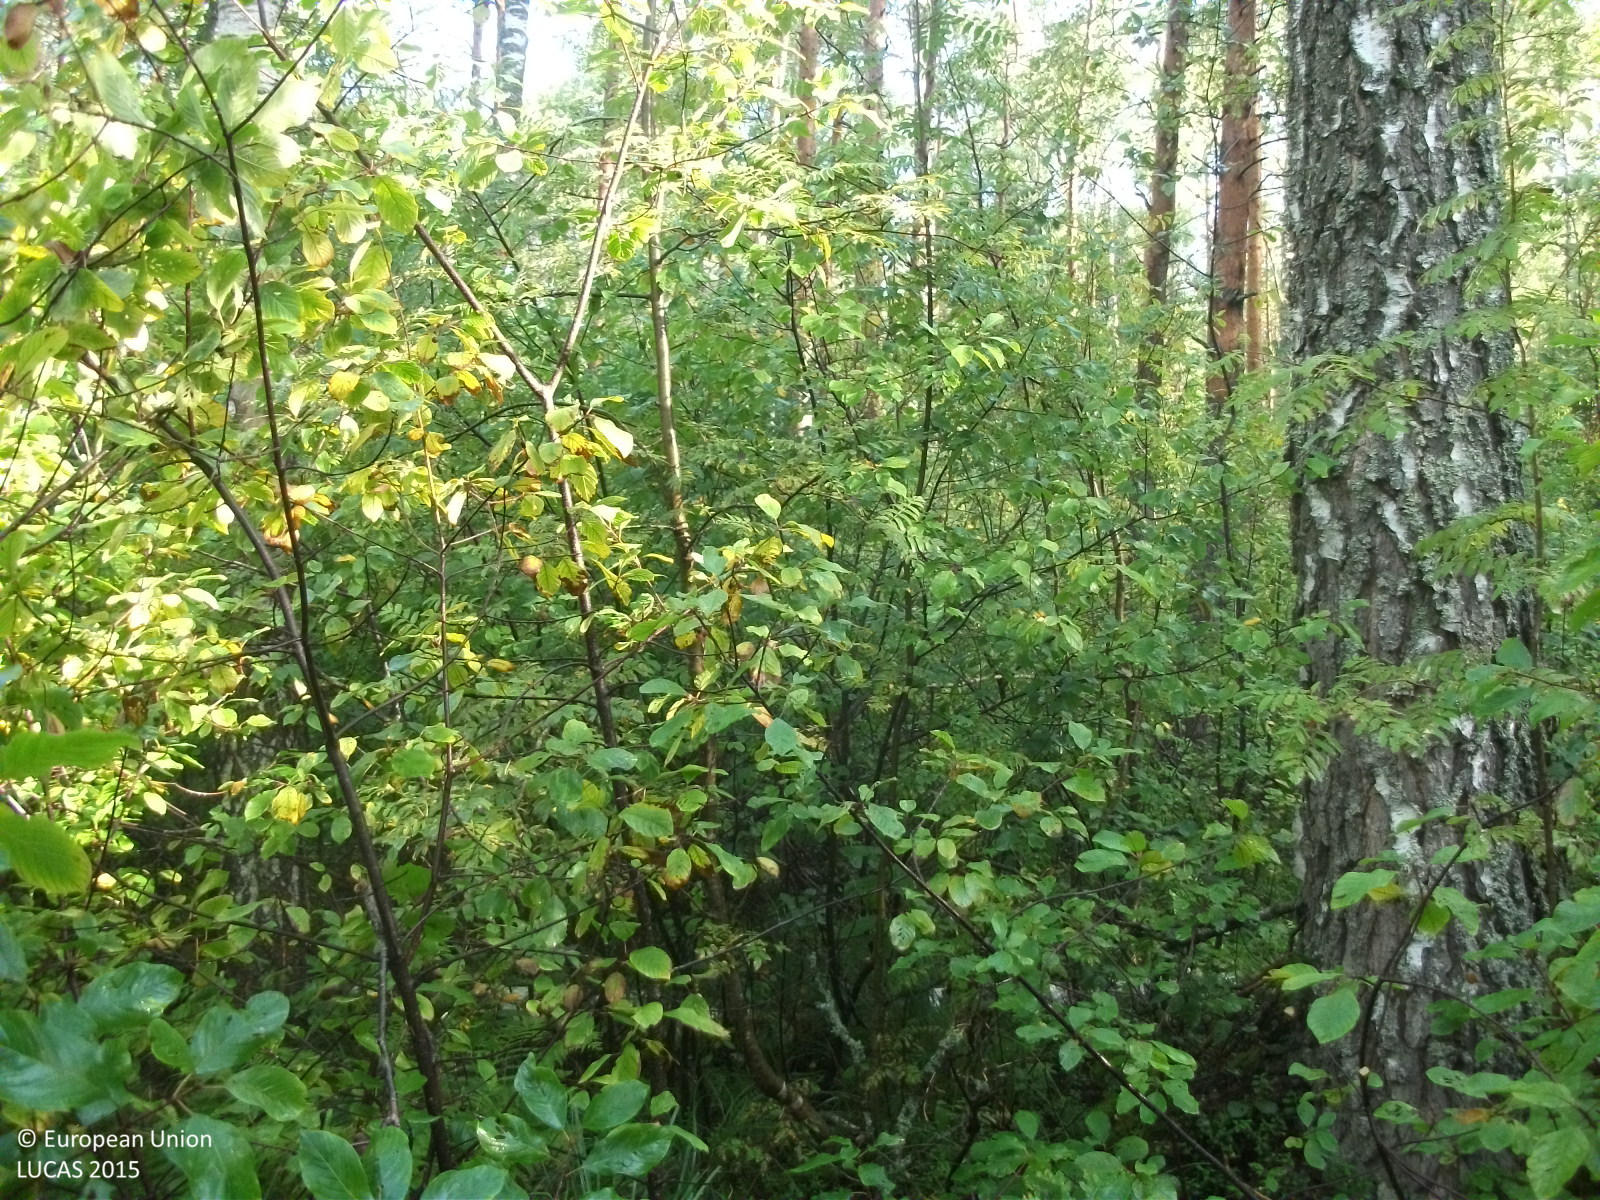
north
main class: Woodland
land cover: Broadleaved woodland
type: non-riverine alder, birch or aspen forest
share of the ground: 50 - 75 %
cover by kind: broadleaved forest trees 55 %, shrubs 30 %, coniferous forest trees 15 %
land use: Forestry
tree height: > 5 m
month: September
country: LV
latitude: 57.5495
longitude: 24.7168
